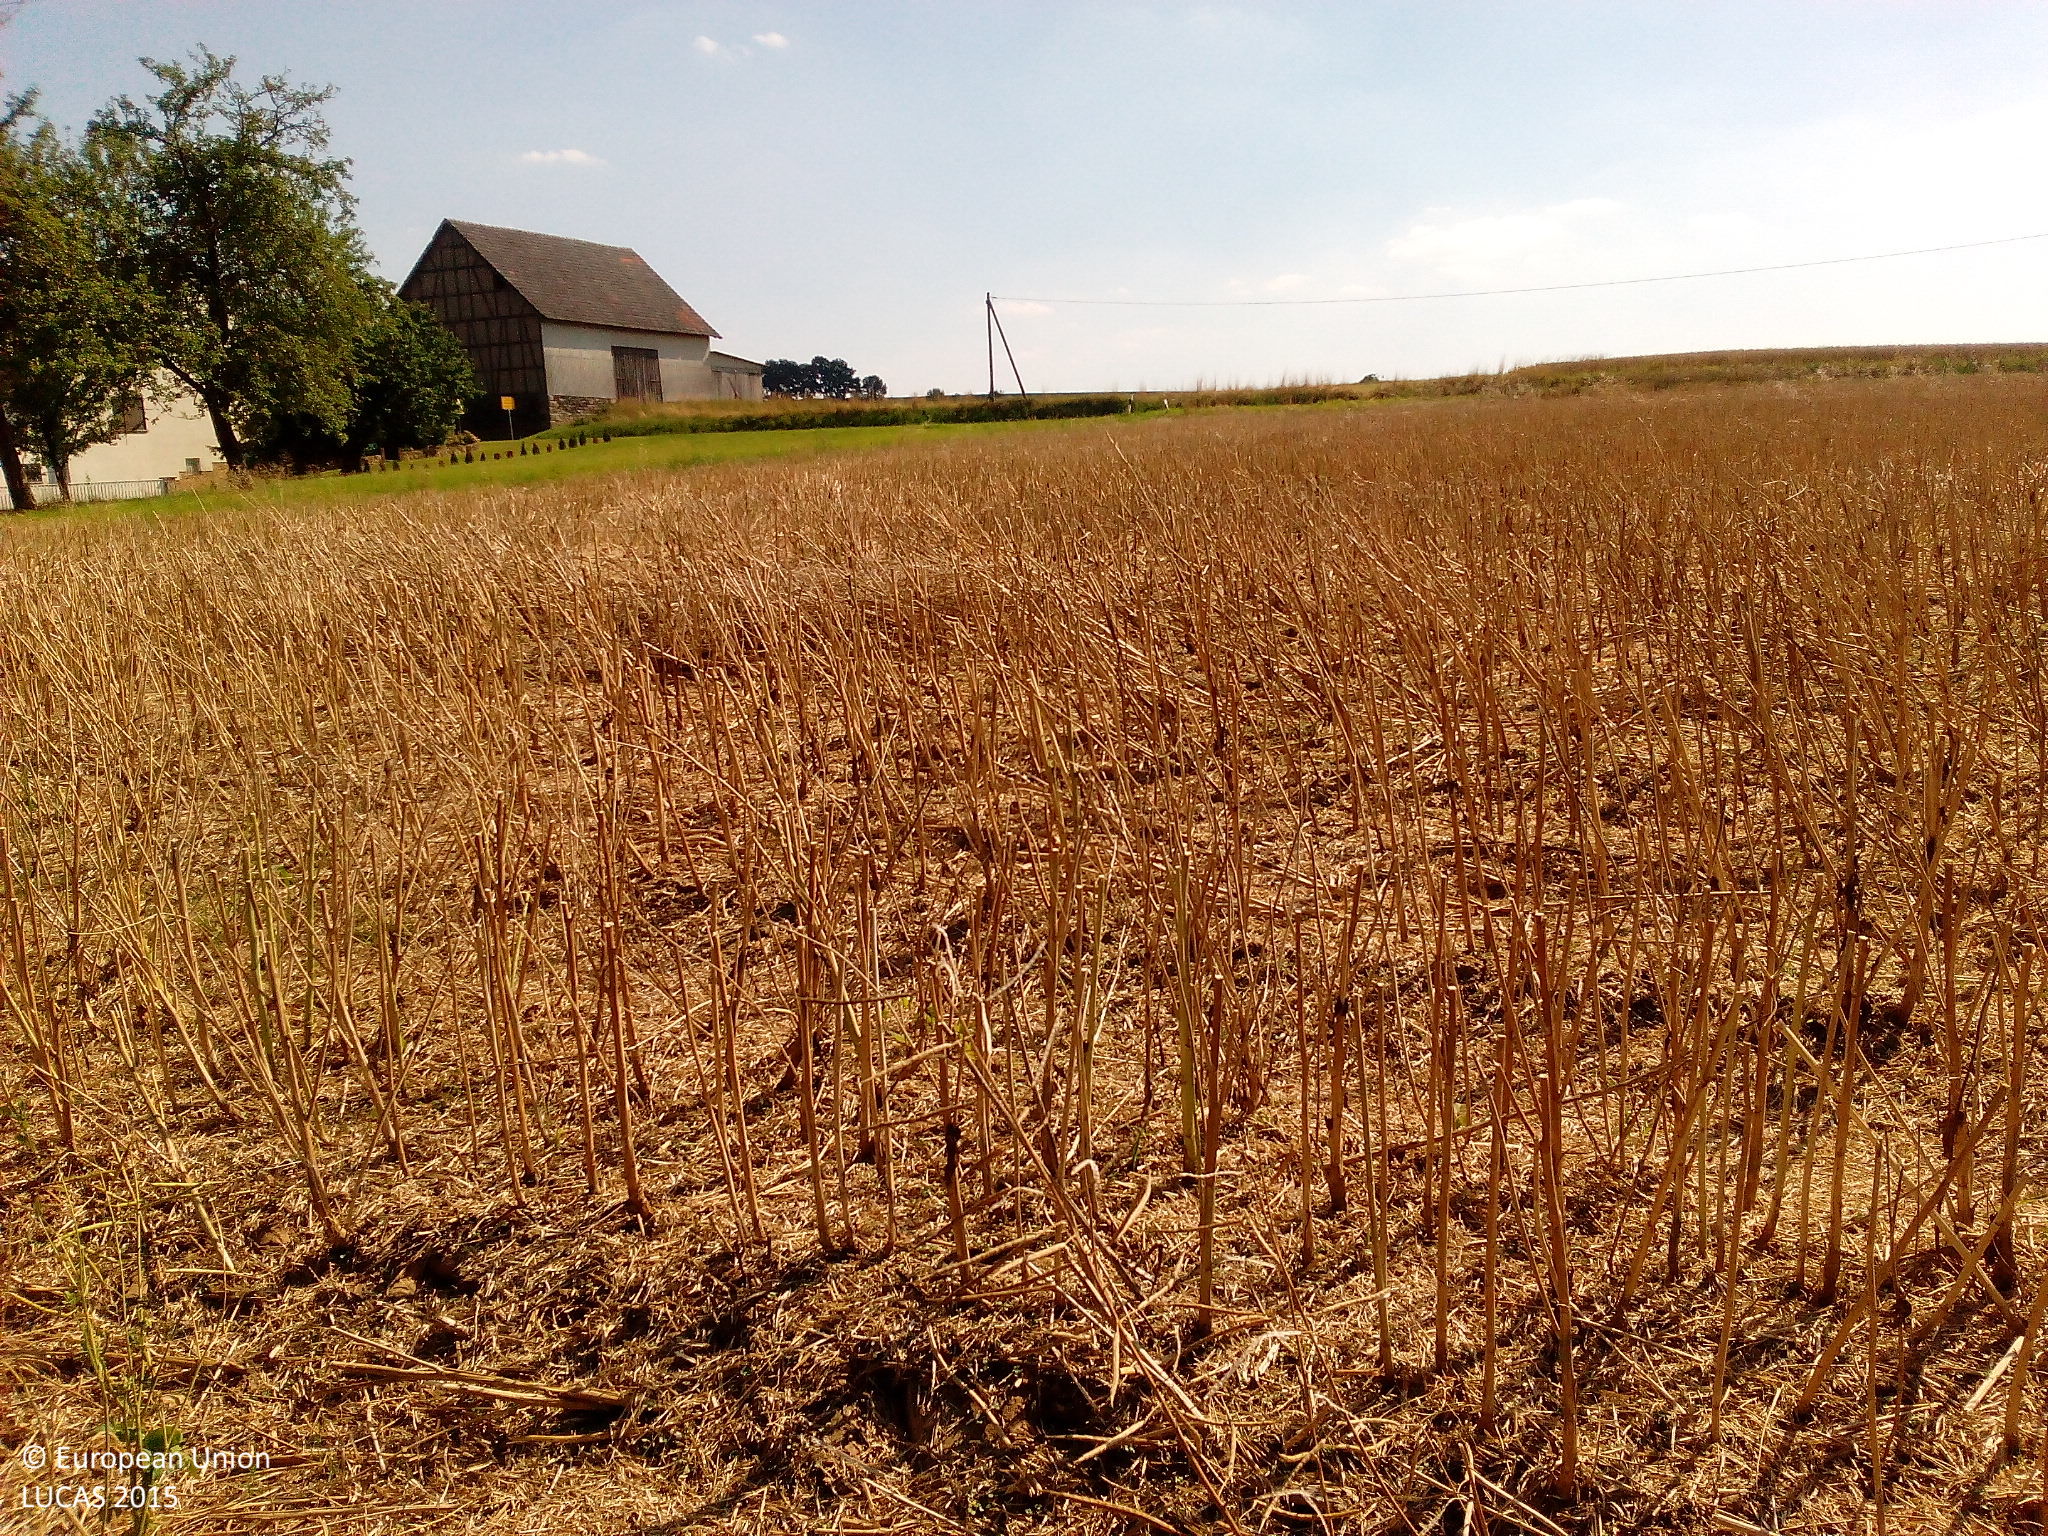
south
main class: Cropland
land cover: Rape and turnip rape
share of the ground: < 10 %
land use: Agriculture (excluding fallow land and kitchen gardens)
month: August
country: DE
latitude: 50.7935
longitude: 9.3051
